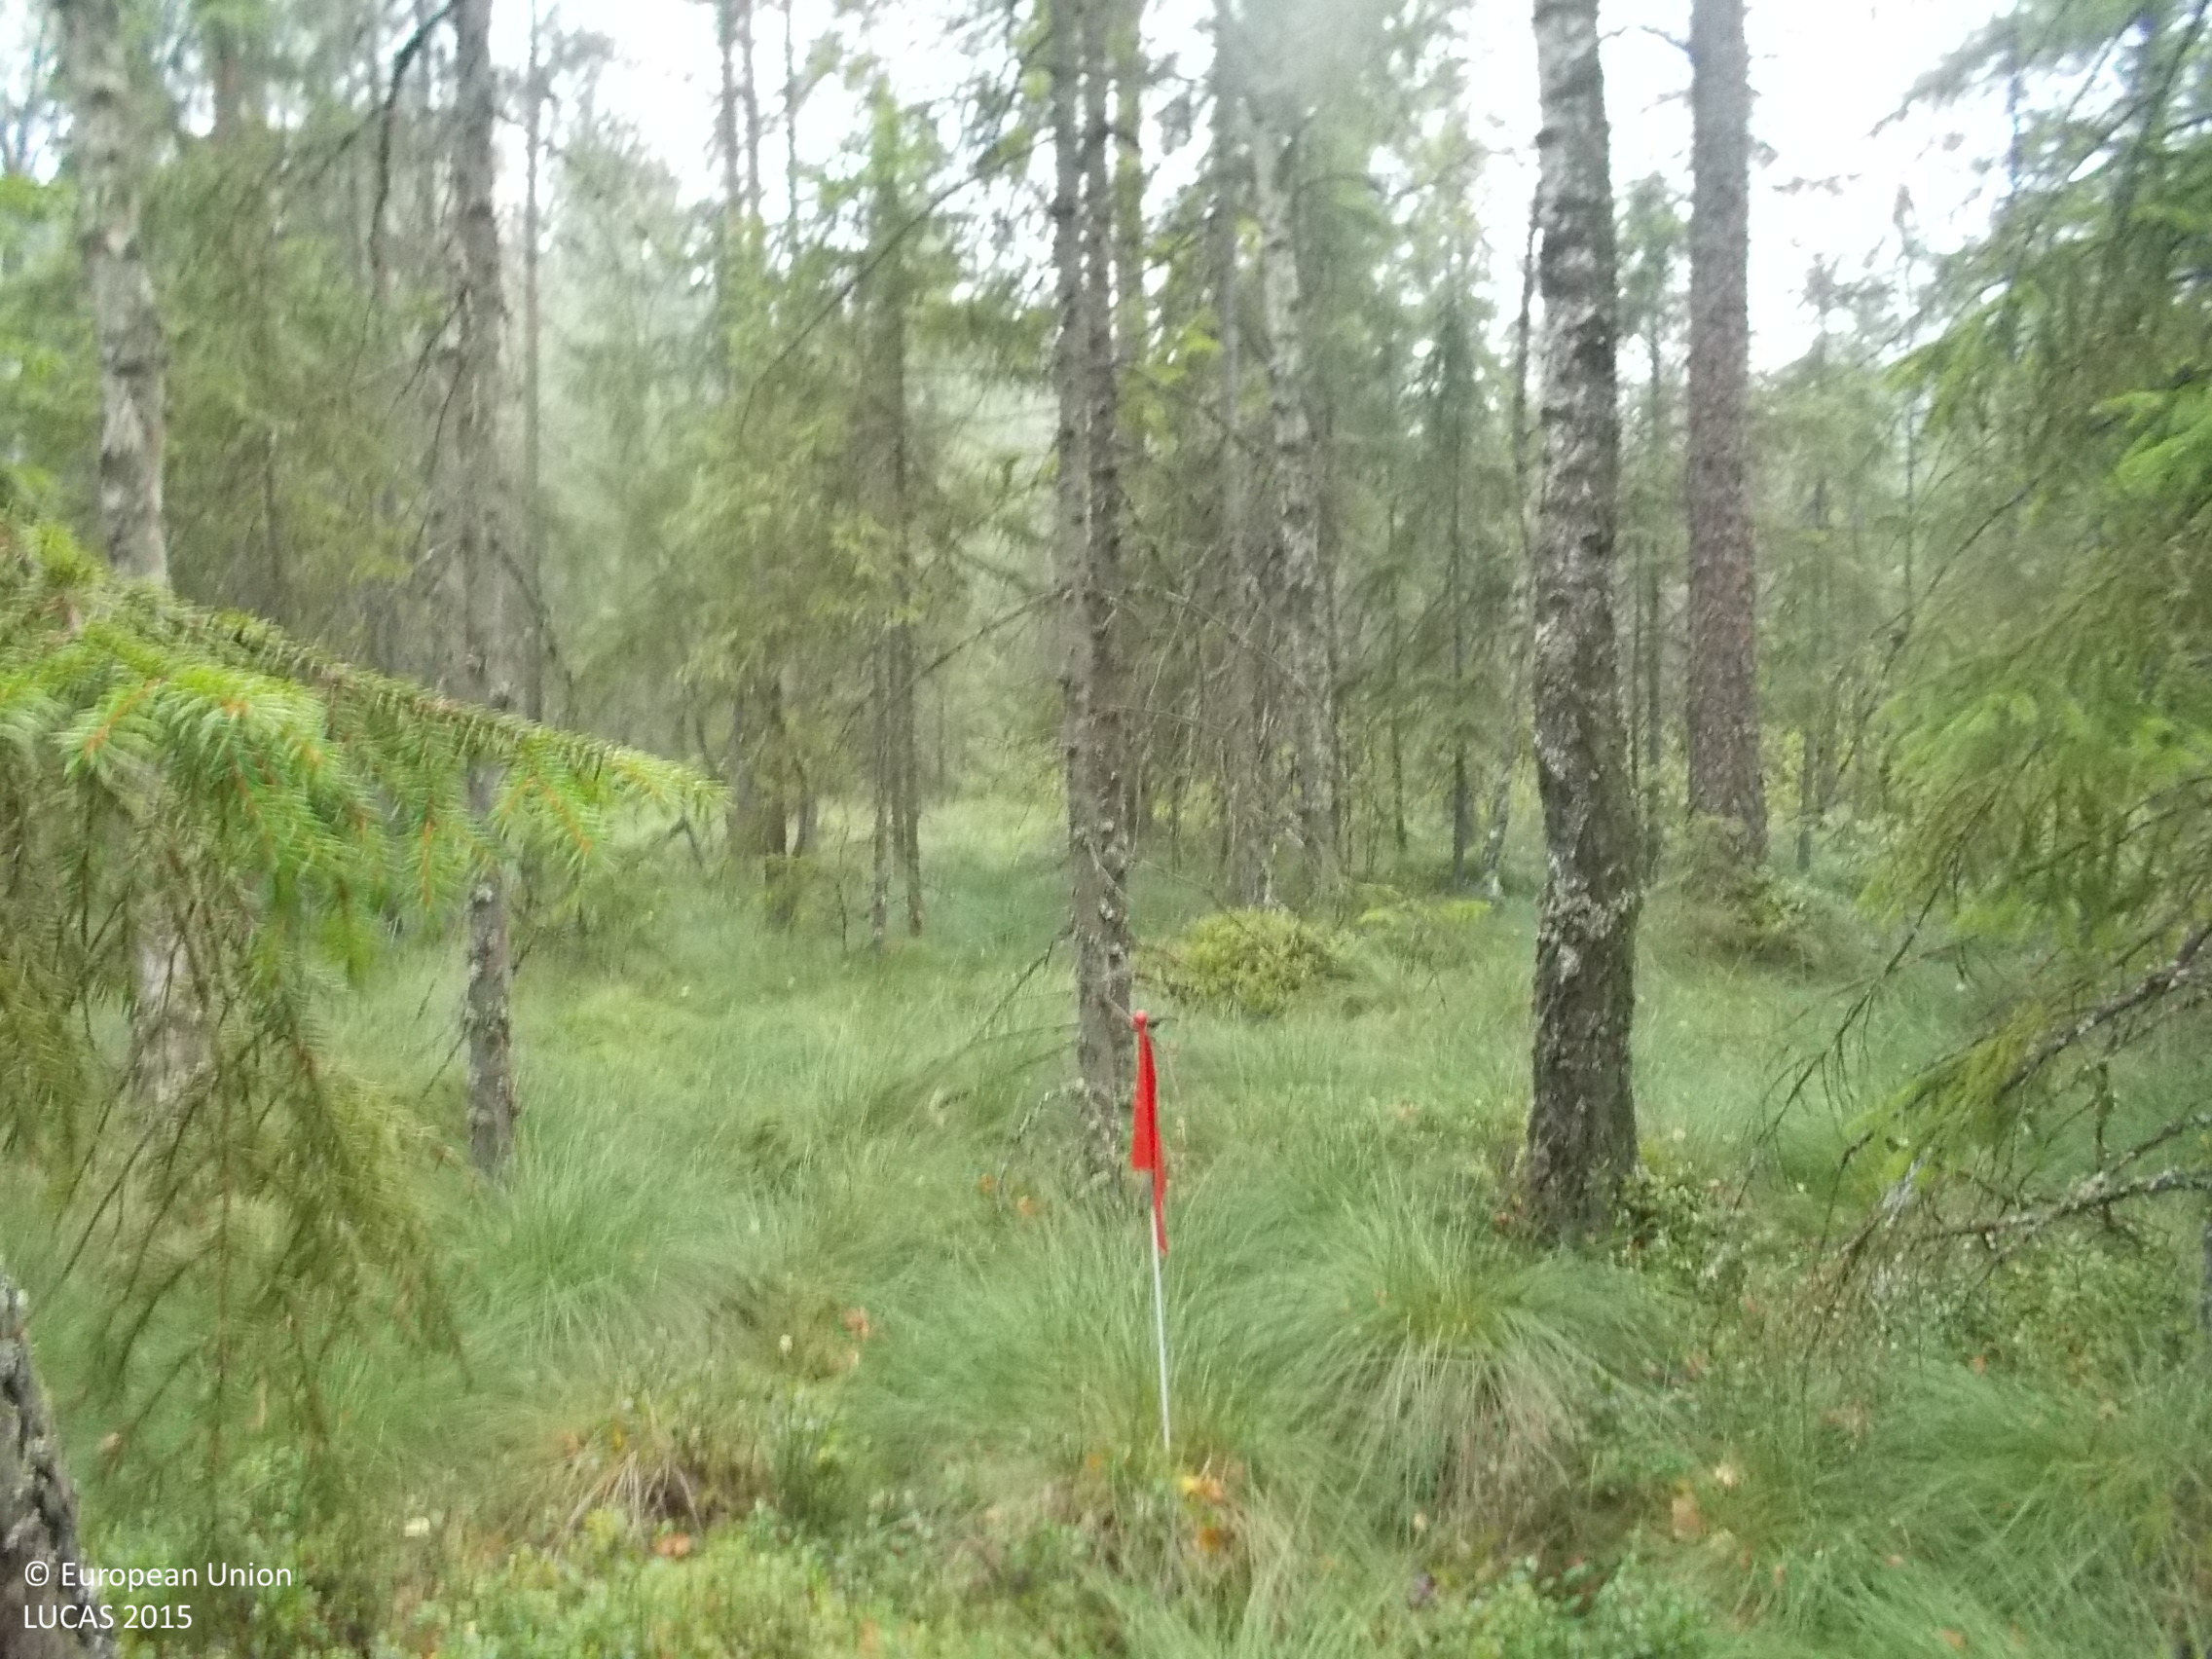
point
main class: Woodland
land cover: Pine dominated mixed woodland
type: boreal forest
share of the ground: > 75 %
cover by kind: coniferous forest trees 60 %, broadleaved forest trees 25 %, shrubs 10 %, lichens and mosses 5 %
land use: Forestry
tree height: > 5 m
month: August
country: SE
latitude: 57.3526
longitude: 13.2368
